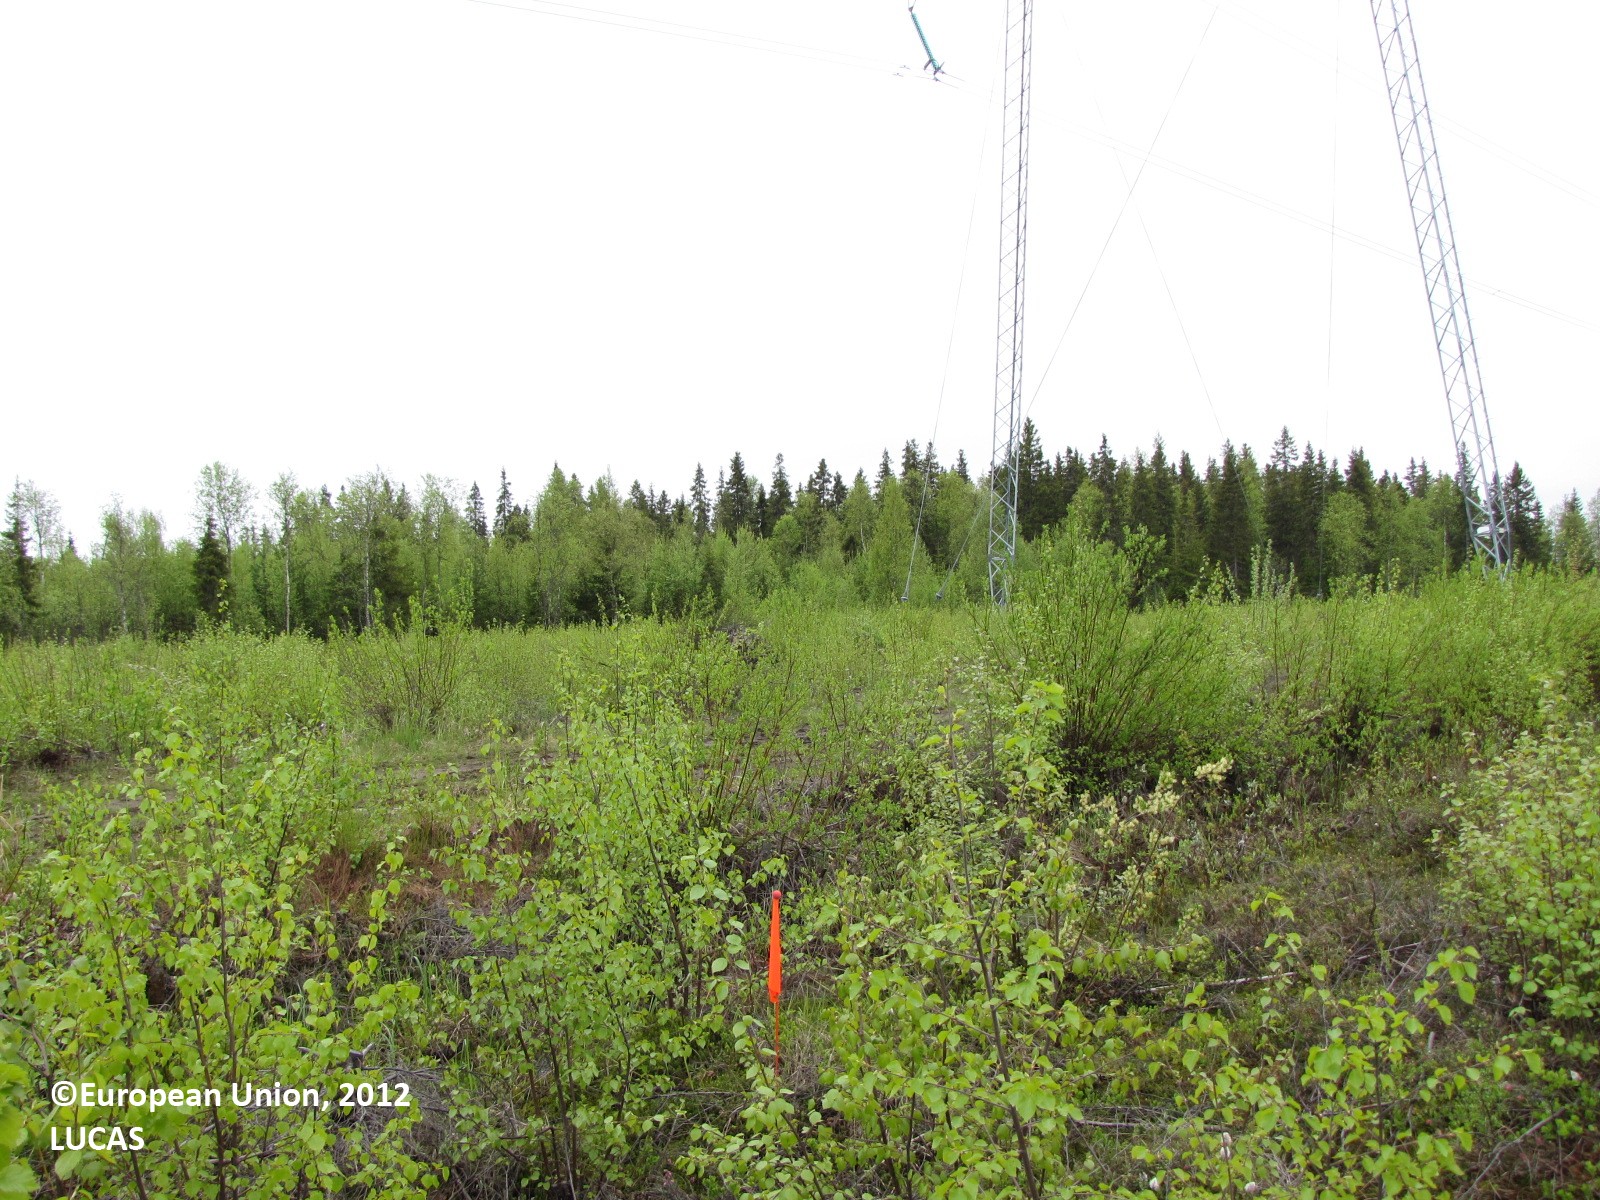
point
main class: Shrubland
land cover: Shrubland with sparse tree cover
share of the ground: > 75 %
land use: Energy production
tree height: < 5 m
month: June
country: FI
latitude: 65.9610
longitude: 24.0579
